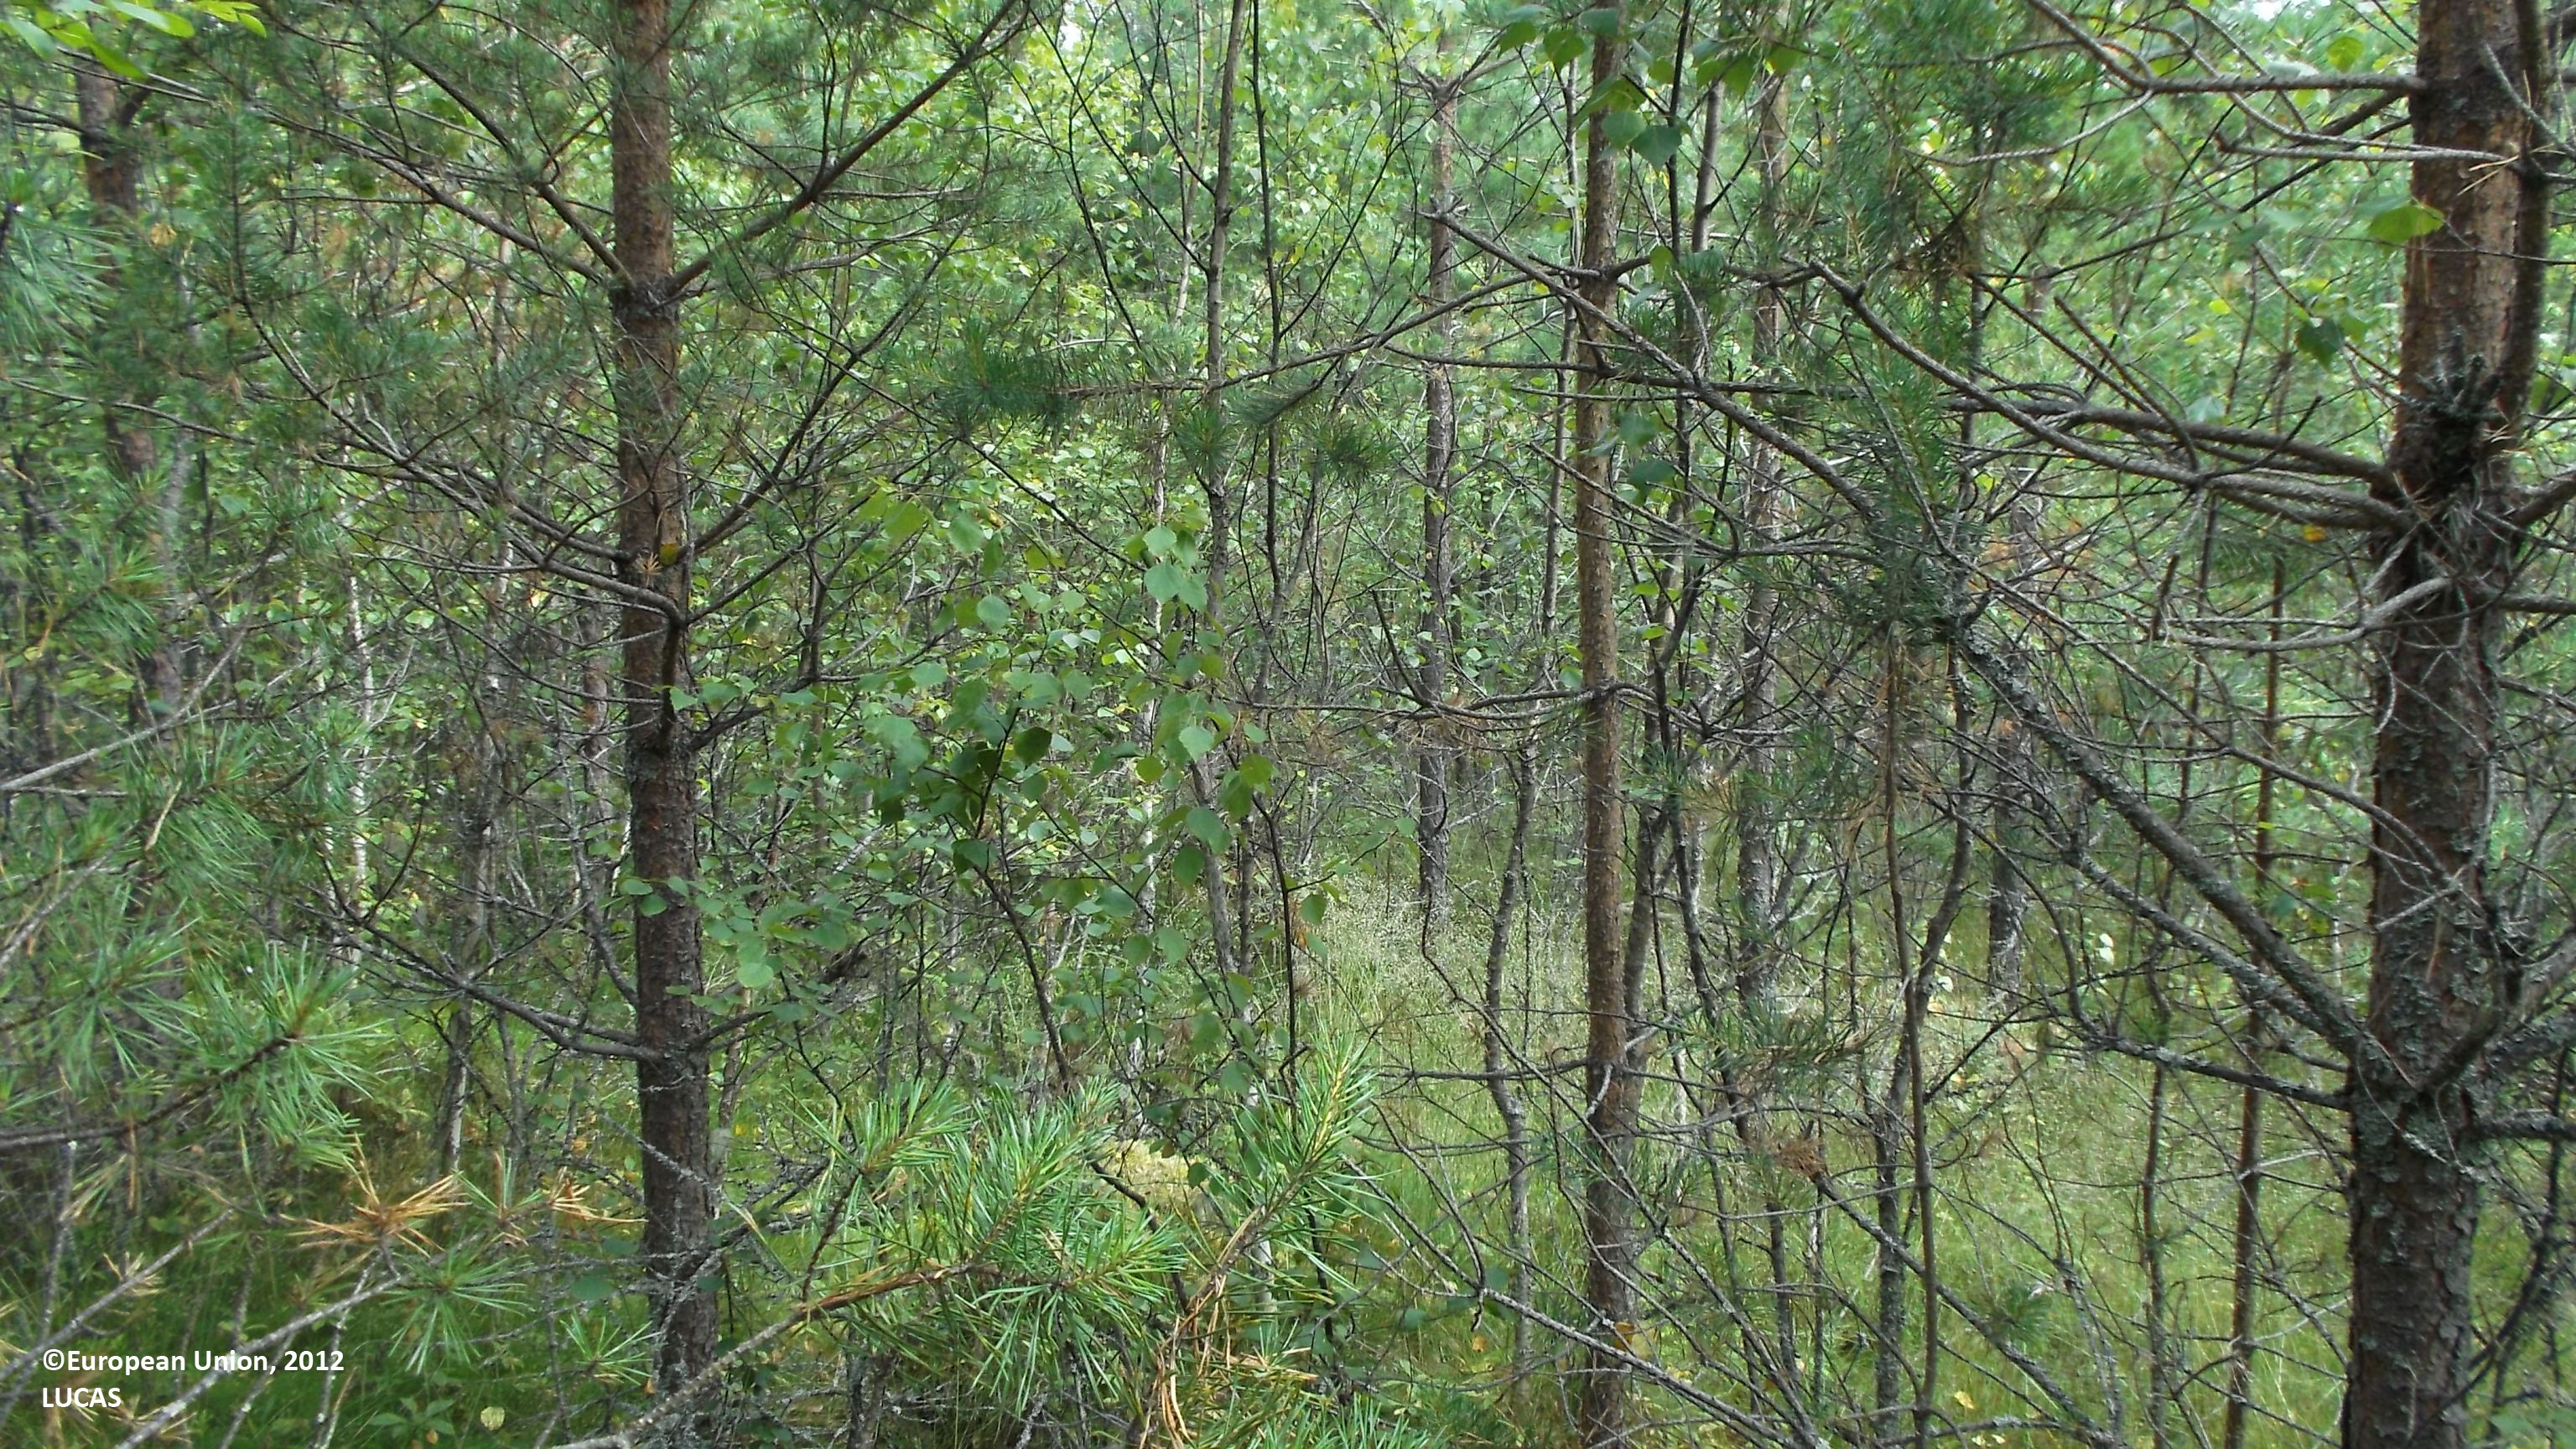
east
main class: Woodland
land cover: Other mixed woodland
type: boreal forest
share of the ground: 50 - 75 %
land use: Forestry
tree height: > 5 m
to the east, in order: Other mixed woodland; Ditches and canals; Other mixed woodland; Spruce dominated mixed woodland; Ditches and canals; Other mixed woodland; Ditches and canals; Pine dominated mixed woodland
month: July
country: FI
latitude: 63.6638
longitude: 23.3725
